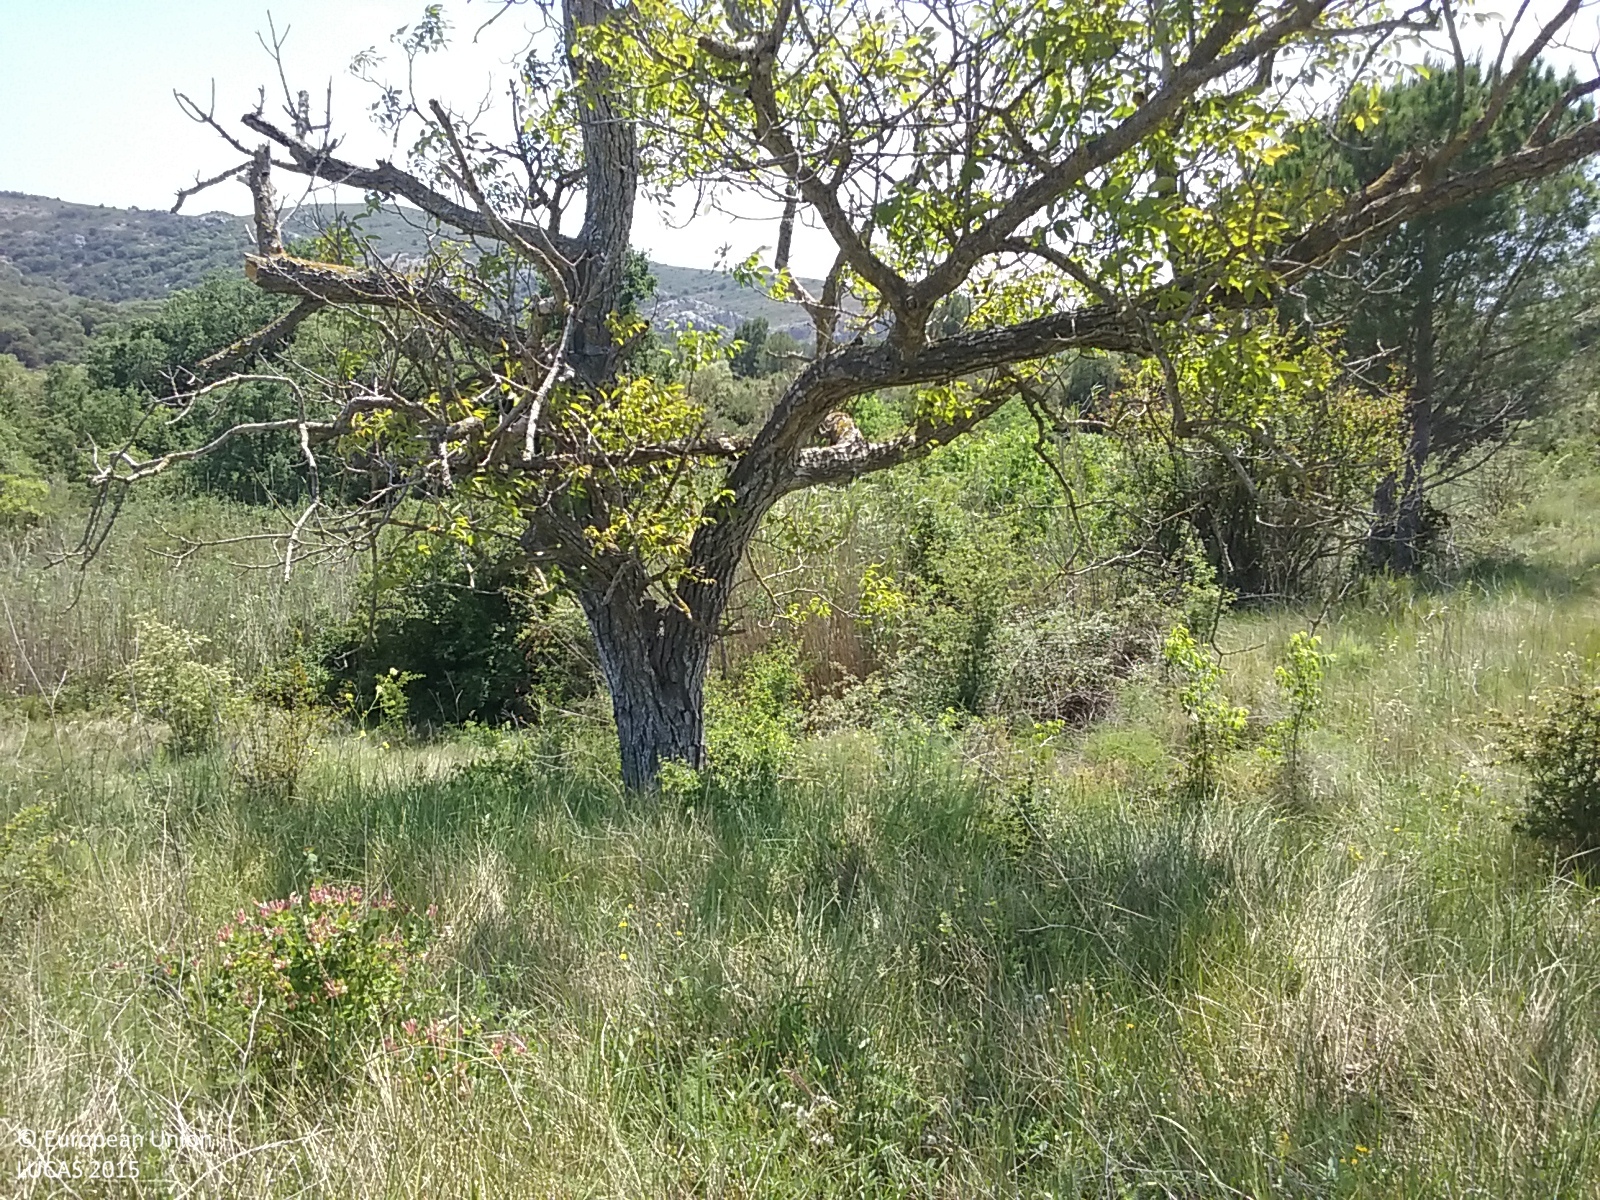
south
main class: Grassland
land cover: Grassland with sparse tree/shrub cover
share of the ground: > 75 %
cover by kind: herbaceous plants 90 %, broadleaved forest trees 5 %, shrubs 5 %
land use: Abandoned areas
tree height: > 5 m
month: May
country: ES
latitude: 40.5457
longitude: 0.2536
